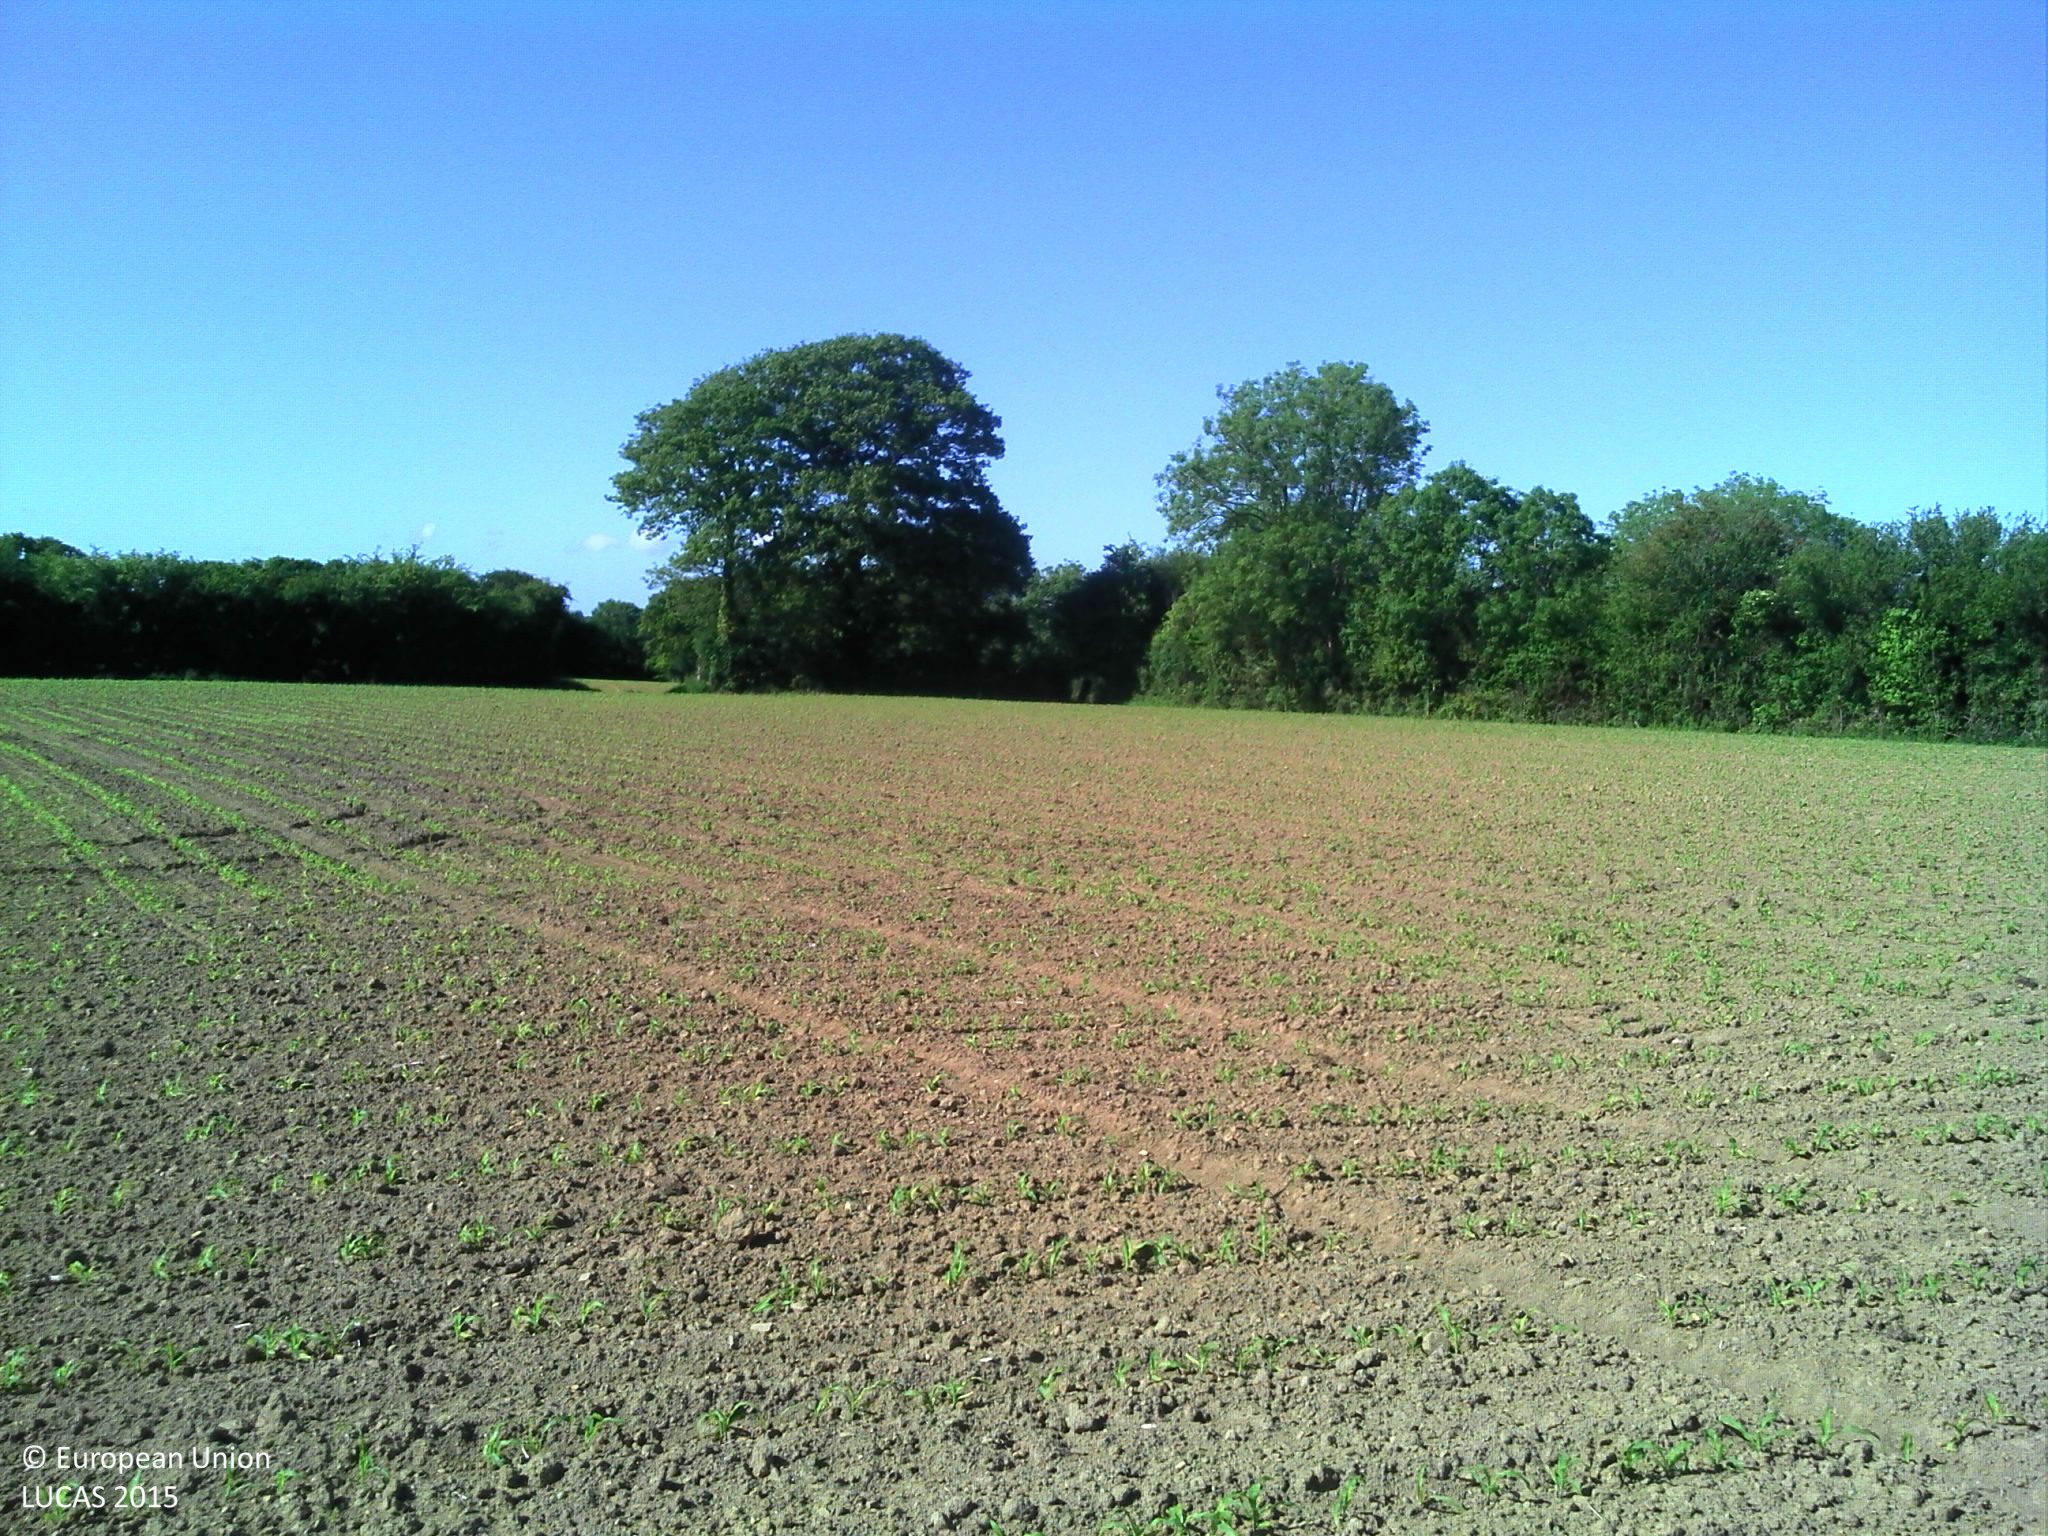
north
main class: Cropland
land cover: Maize
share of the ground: < 10 %
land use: Agriculture (excluding fallow land and kitchen gardens)
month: June
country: FR
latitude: 49.4839
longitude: -1.7443
